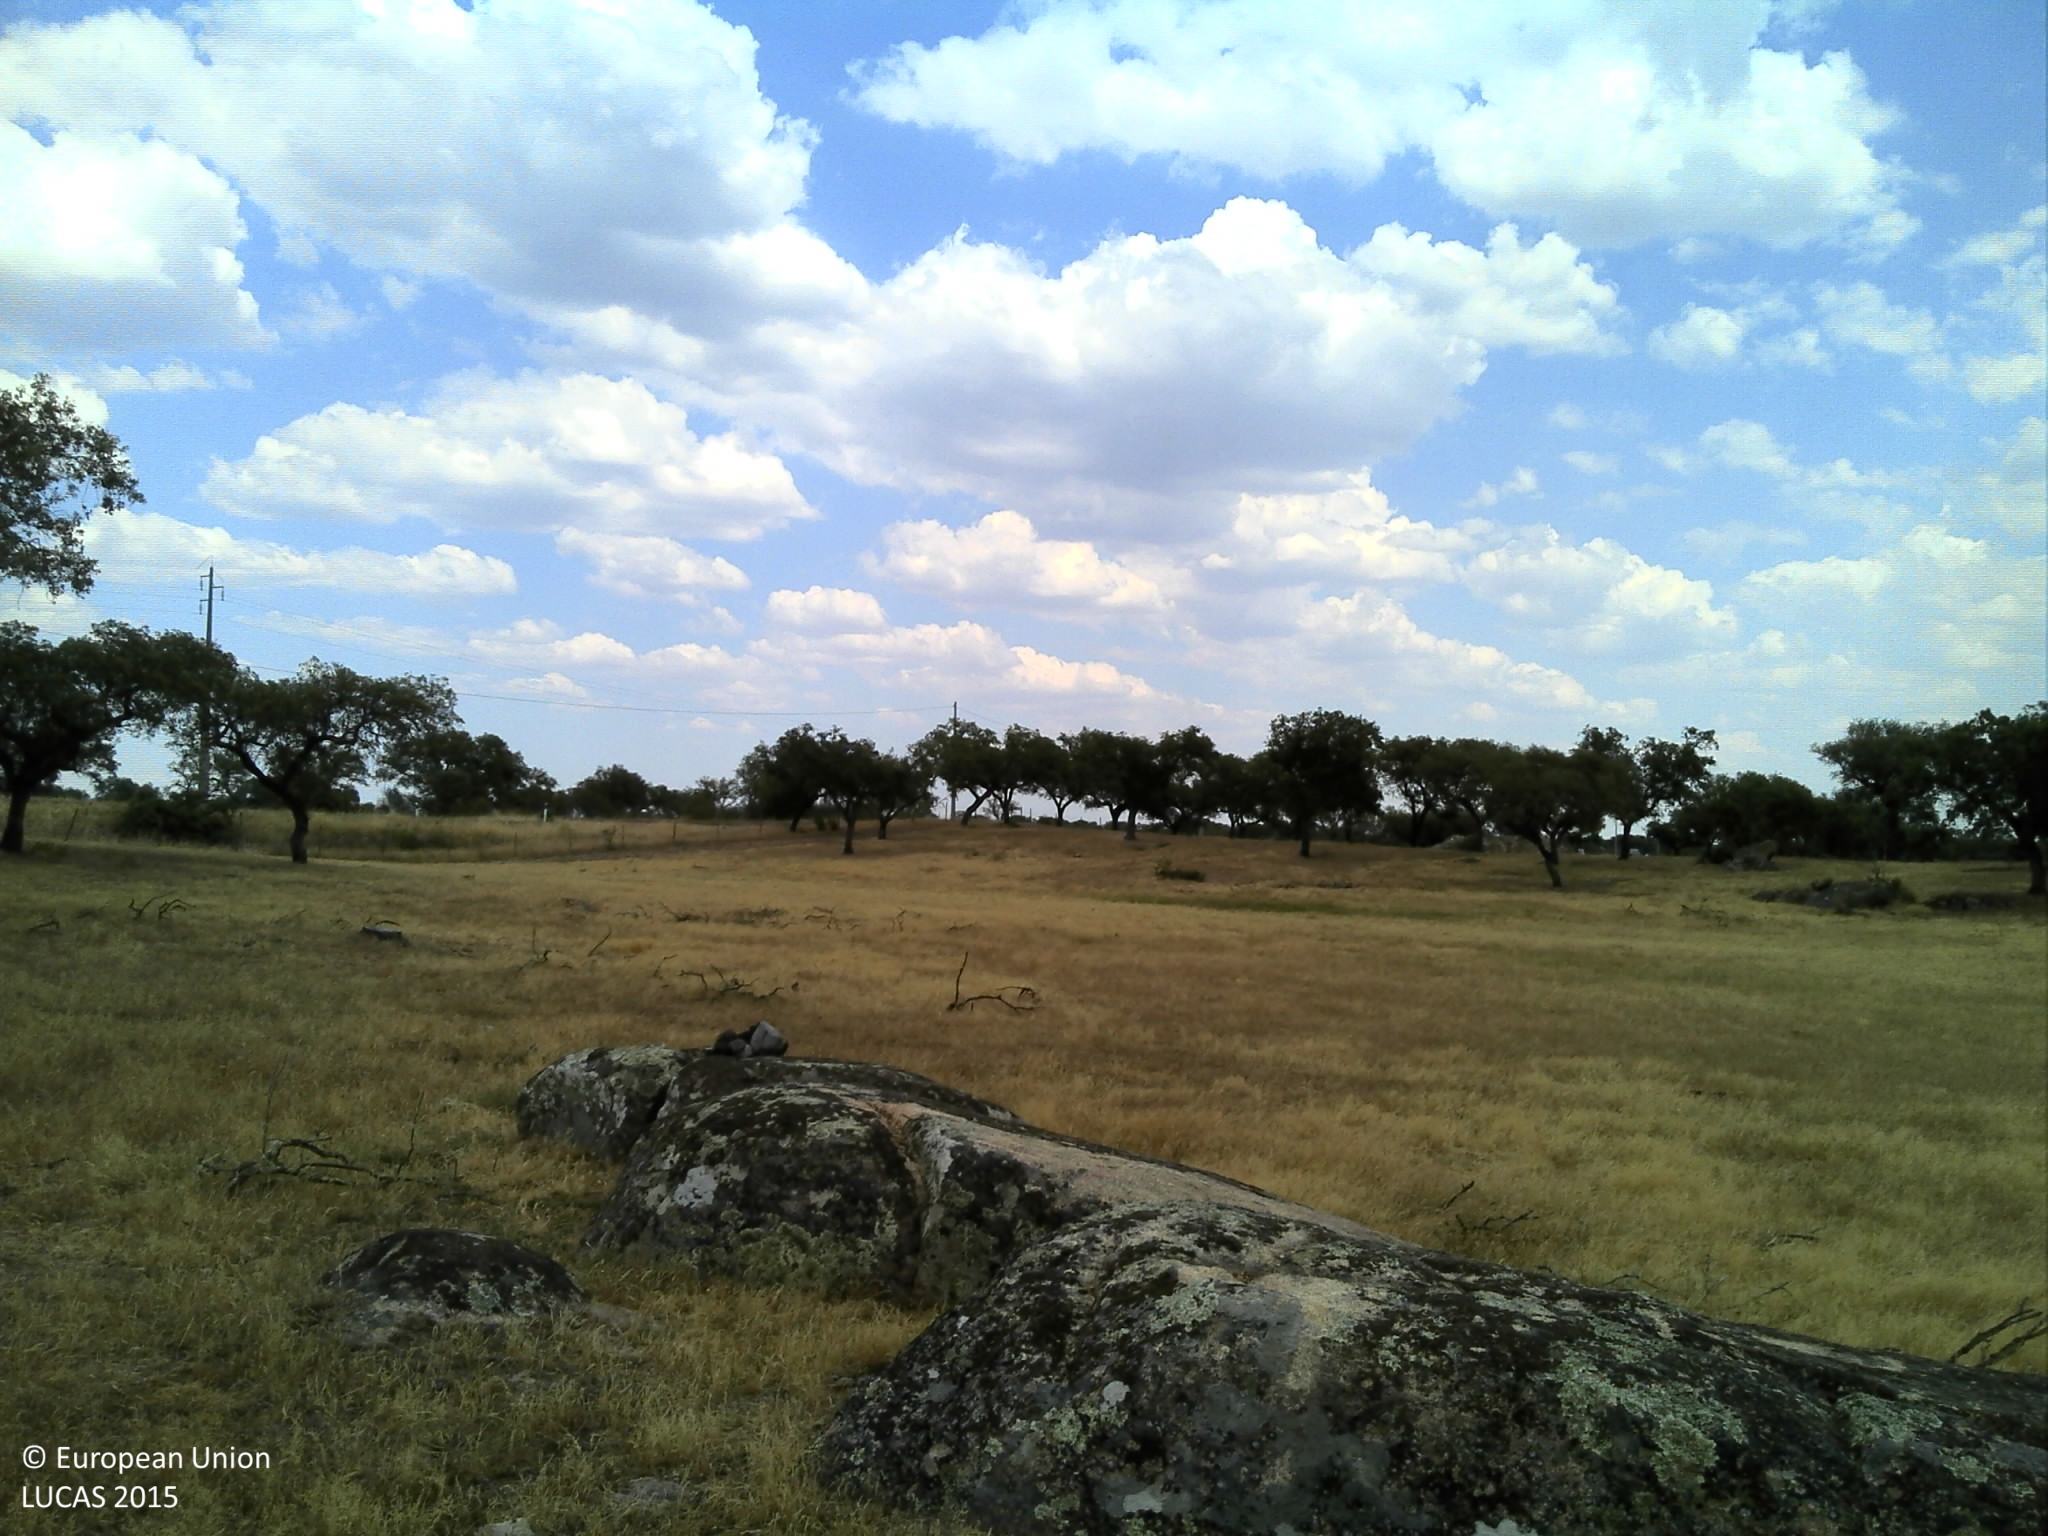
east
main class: Woodland
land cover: Broadleaved woodland
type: broadleaved evergreen forest
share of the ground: 10 - 25 %
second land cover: Grassland without tree/shrub cover
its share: 25 - 50 %
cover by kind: herbaceous plants 50 %, broadleaved forest trees 25 %, unconsolidated bare surface 25 %
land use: Forestry
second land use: Agriculture (excluding fallow land and kitchen gardens)
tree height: > 5 m
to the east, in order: Broadleaved woodland; Grassland without tree/shrub cover; Broadleaved woodland; Grassland without tree/shrub cover; Broadleaved woodland; Grassland without tree/shrub cover; Broadleaved woodland; Fences; Grassland without tree/shrub cover; Ditches and canals; Grass margins; Electric lines; Paved roads, cycling and walking lanes; Grass margins; Fences; Rock outcrops; Grassland without tree/shrub cover
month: May
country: PT
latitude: 38.8477
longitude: -7.8920
